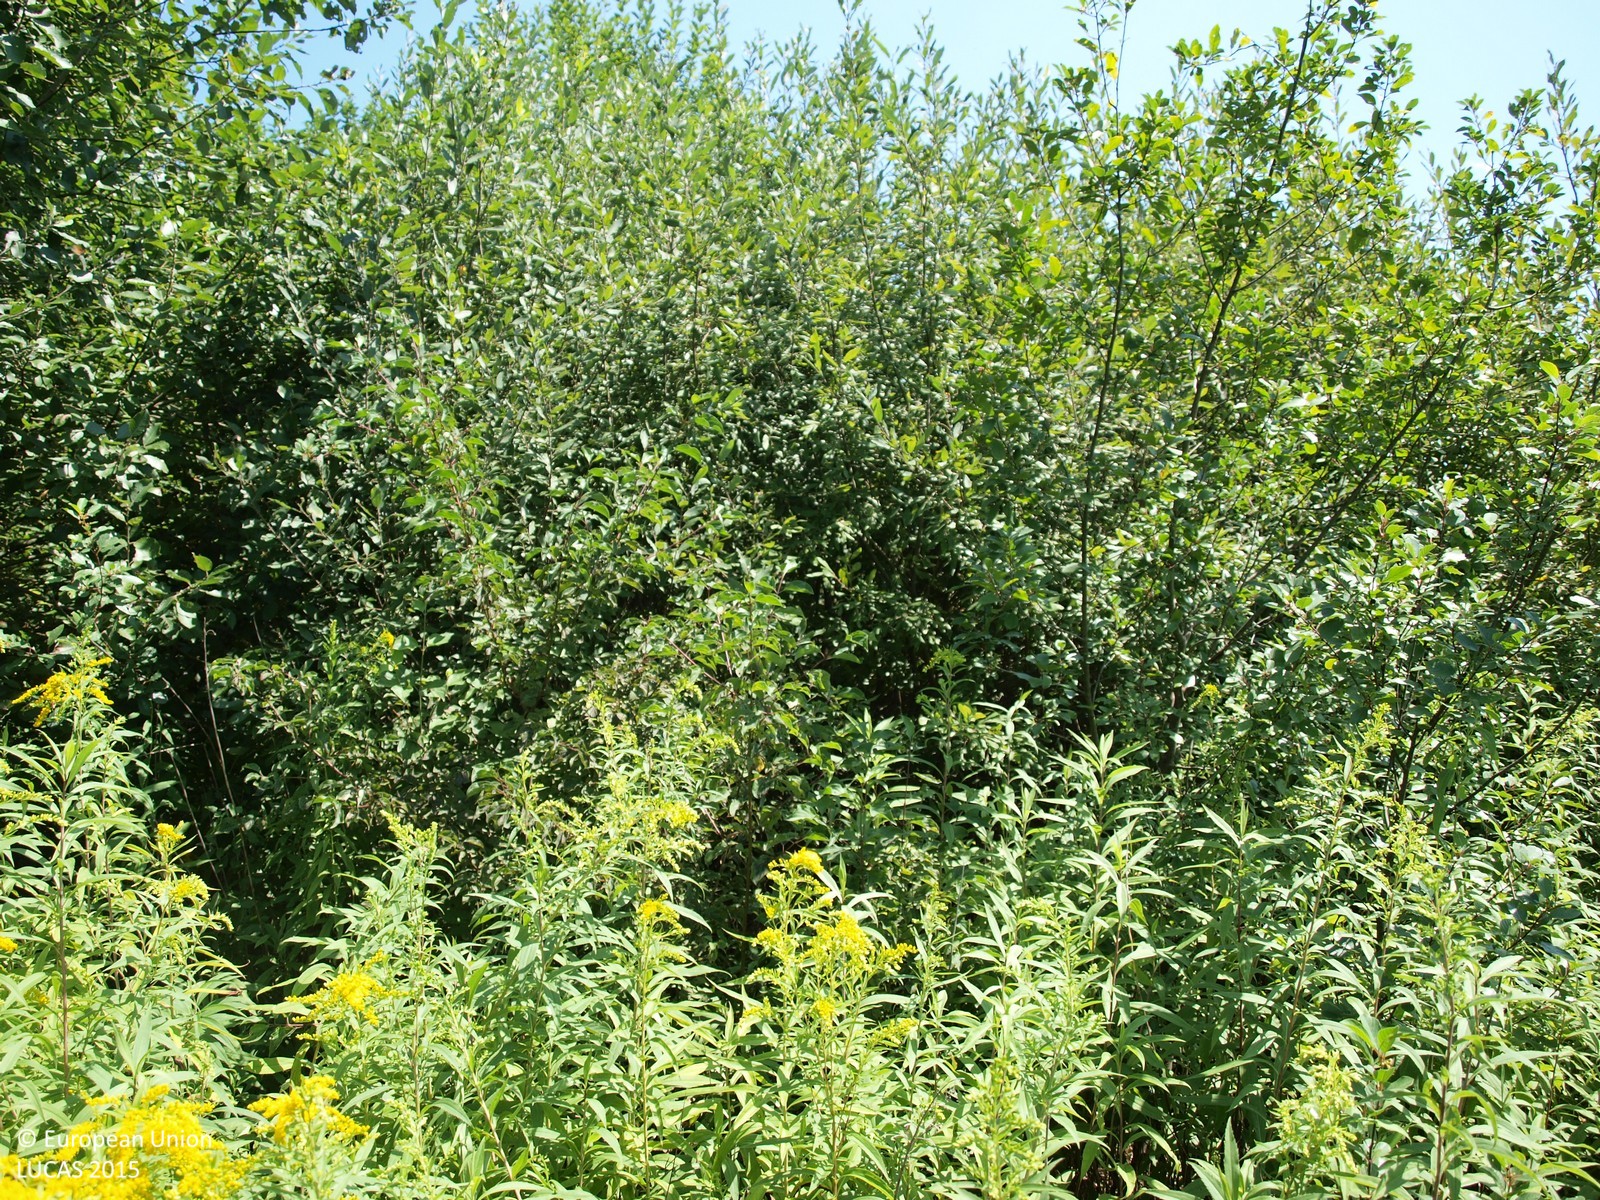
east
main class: Shrubland
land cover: Shrubland with sparse tree cover
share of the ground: > 75 %
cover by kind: shrubs 95 %, broadleaved forest trees 5 %
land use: Abandoned areas
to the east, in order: Shrubland with sparse tree cover; Paved roads, cycling and walking lanes; Grassland without tree/shrub cover; Apple fruit; Paved roads, cycling and walking lanes; Broadleaved woodland; Other fruit trees and berries; Fences; Broadleaved woodland; Grassland without tree/shrub cover; Tracks; Grassland with sparse tree/shrub cover; Abandoned hedges; Grassland without tree/shrub cover; Inland fresh water bodies; Tracks
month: August
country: HR
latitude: 45.8616
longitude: 16.2456
